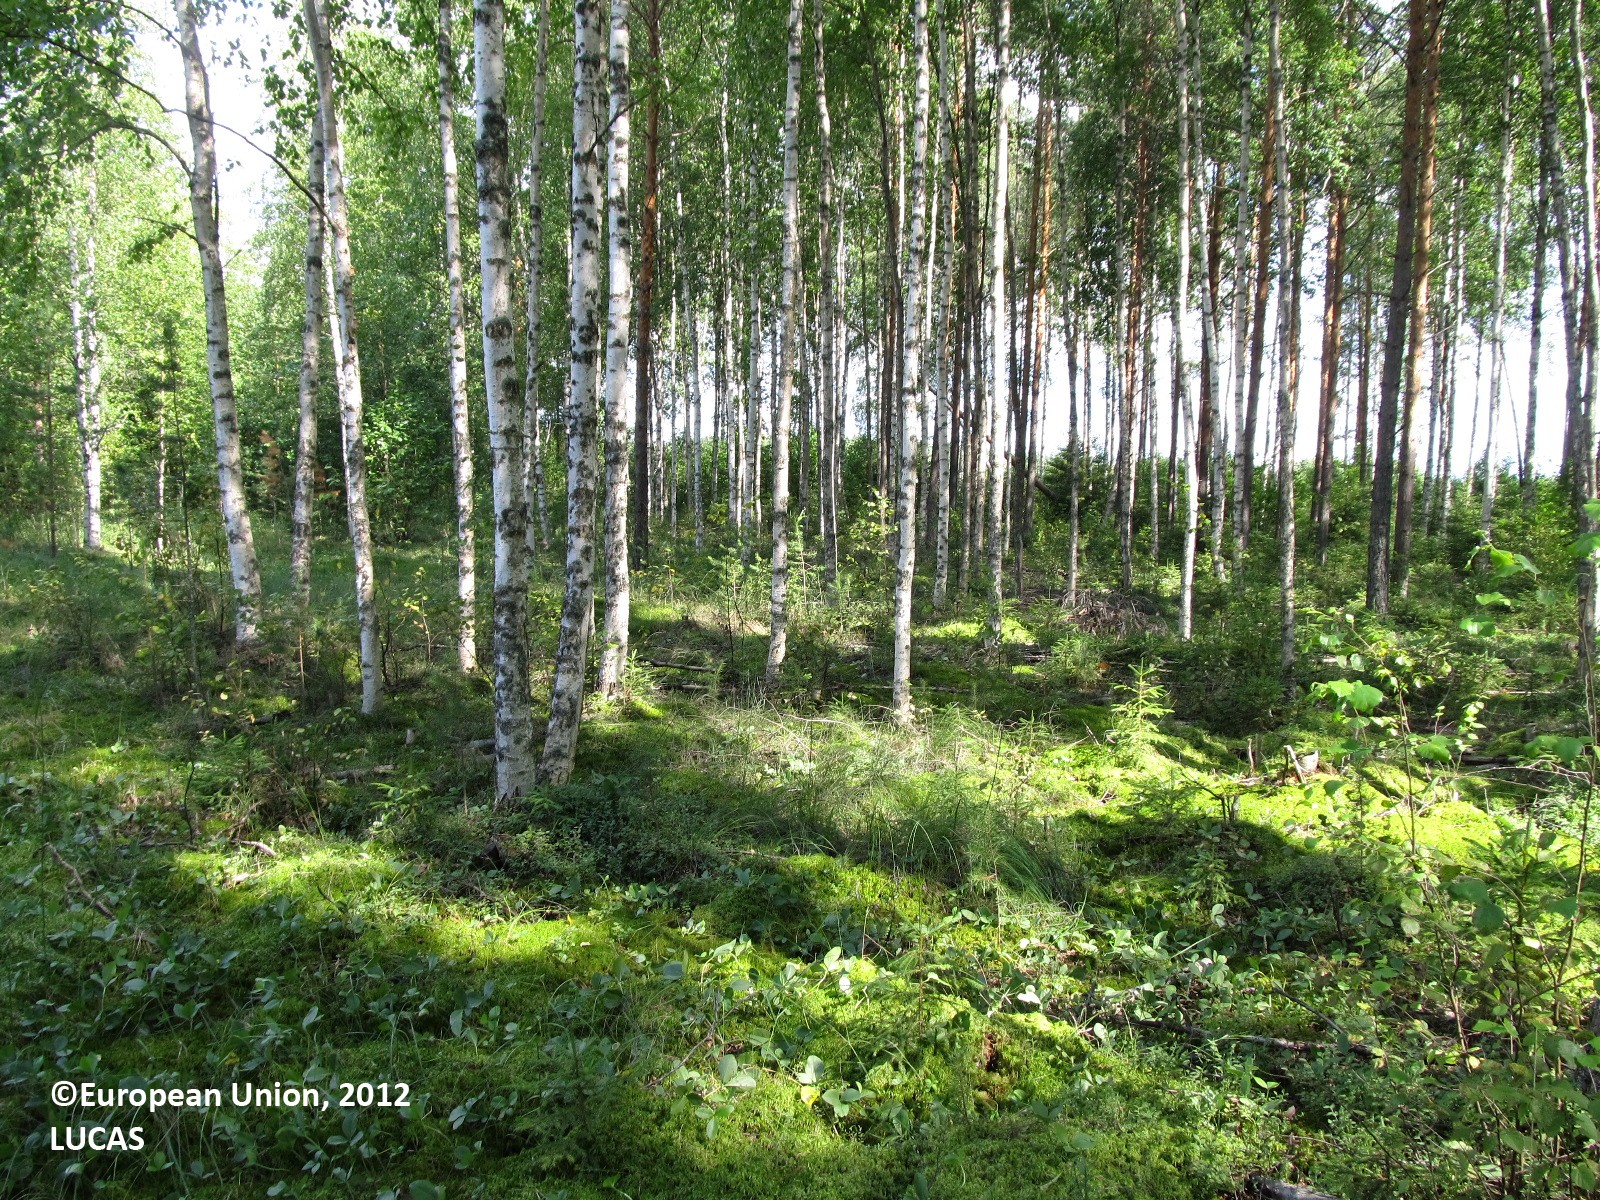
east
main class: Woodland
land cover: Pine dominated mixed woodland
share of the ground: 25 - 50 %
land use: Forestry
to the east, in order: Pine dominated mixed woodland; Ditches and canals; Temporary grasslands; Oats; Temporary grasslands; Ditches and canals; Temporary grasslands
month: July
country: FI
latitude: 62.0858
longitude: 28.1738
